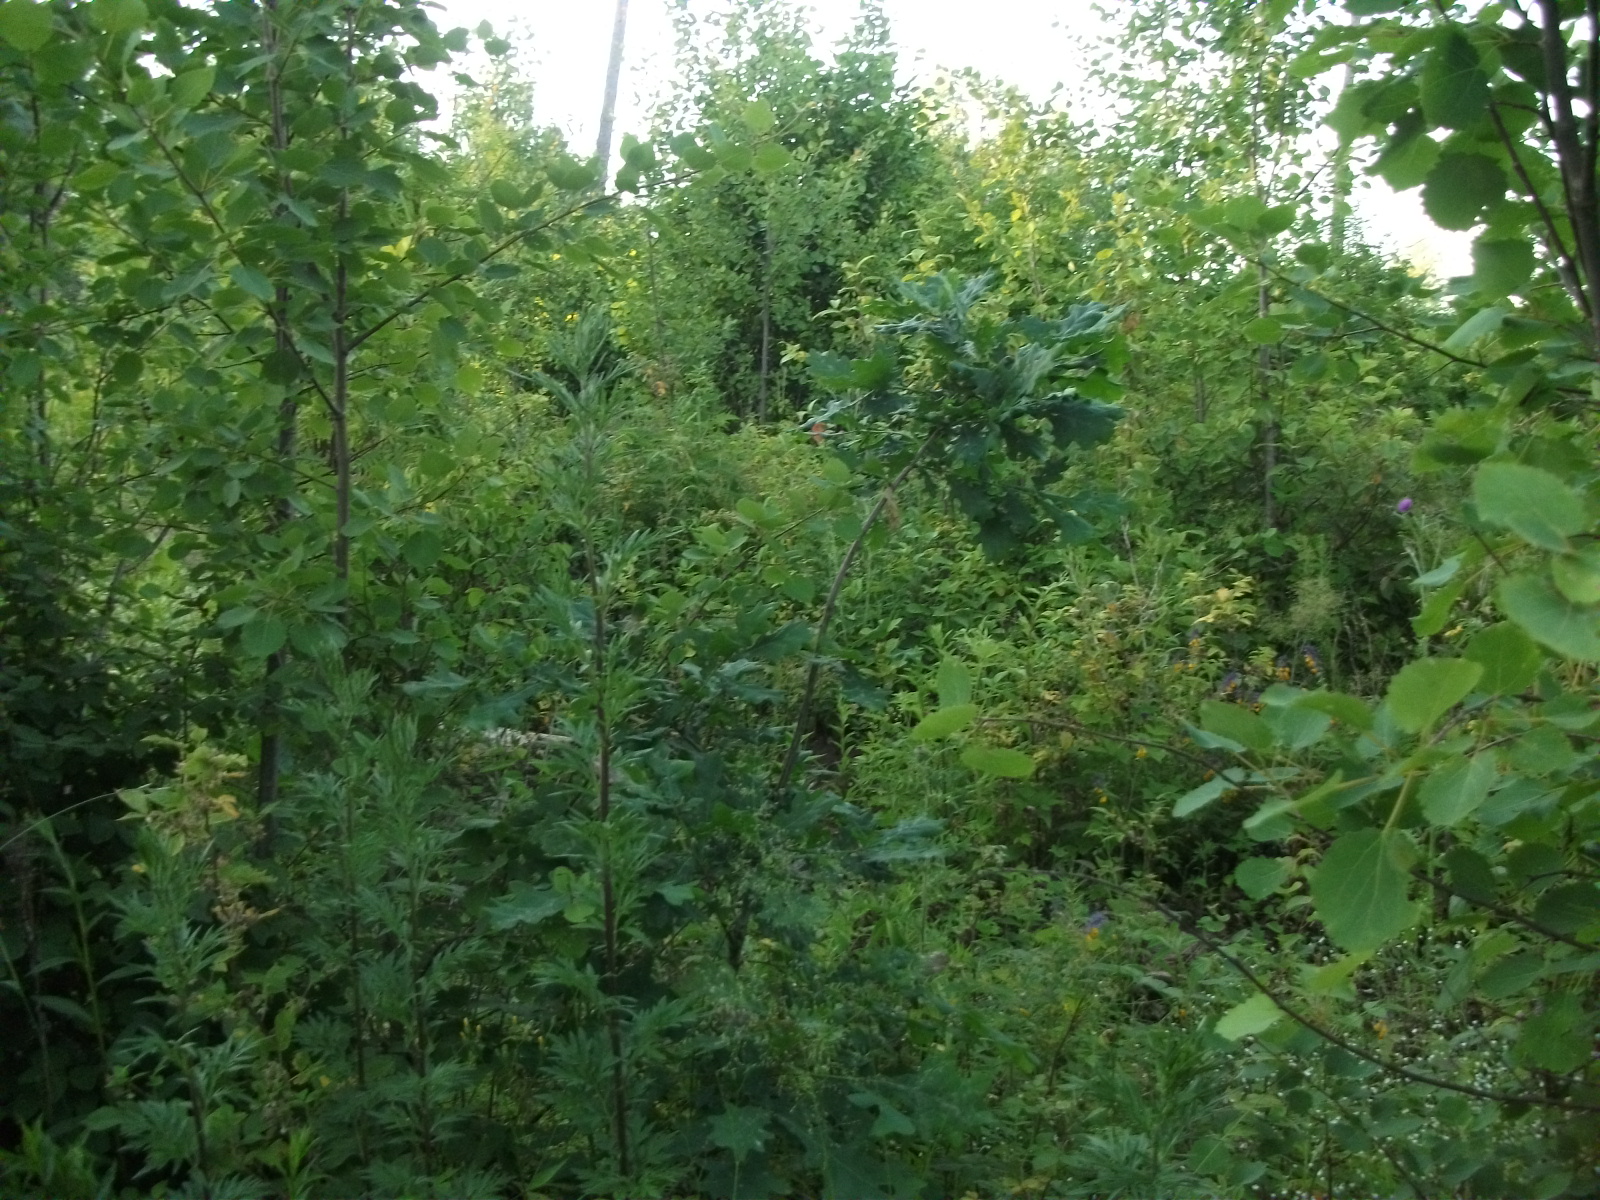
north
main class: Woodland
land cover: Broadleaved woodland
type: non-riverine alder, birch or aspen forest
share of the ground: > 75 %
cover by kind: broadleaved forest trees 80 %, shrubs 10 %, herbaceous plants 10 %
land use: Forestry
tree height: < 5 m
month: July
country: LV
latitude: 56.8377
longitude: 26.2179
